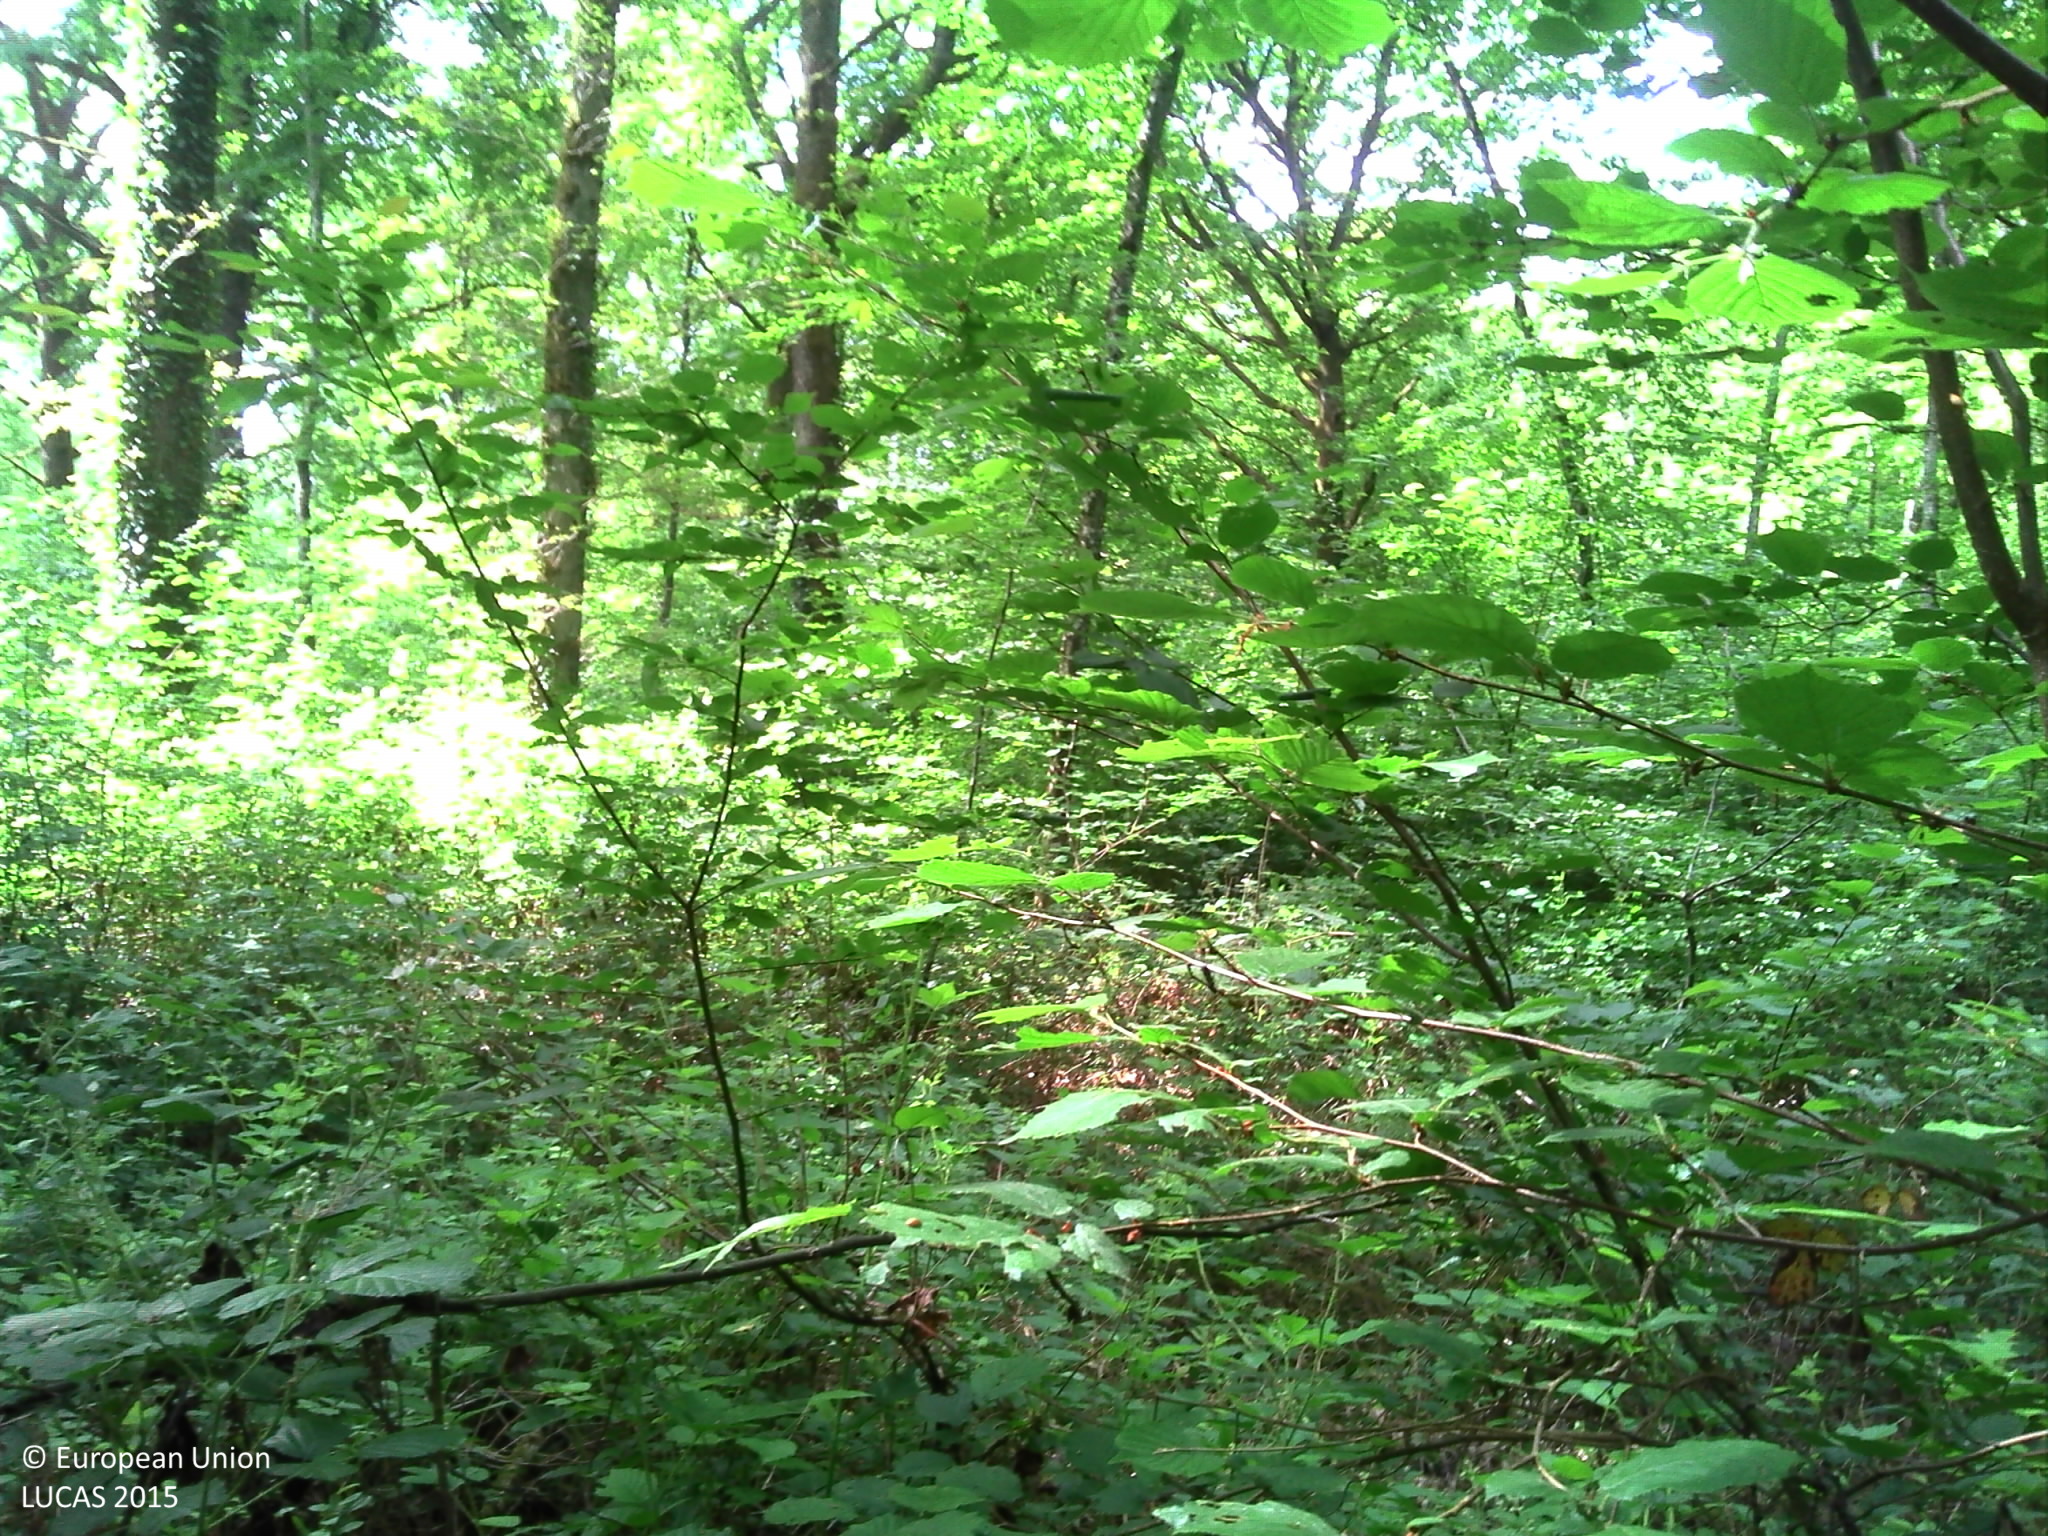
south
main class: Woodland
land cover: Broadleaved woodland
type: mesophytic deciduous forest
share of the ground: > 75 %
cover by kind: broadleaved forest trees 90 %, herbaceous plants 10 %
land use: Forestry
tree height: > 5 m
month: May
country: FR
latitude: 47.2393
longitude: 5.2850
